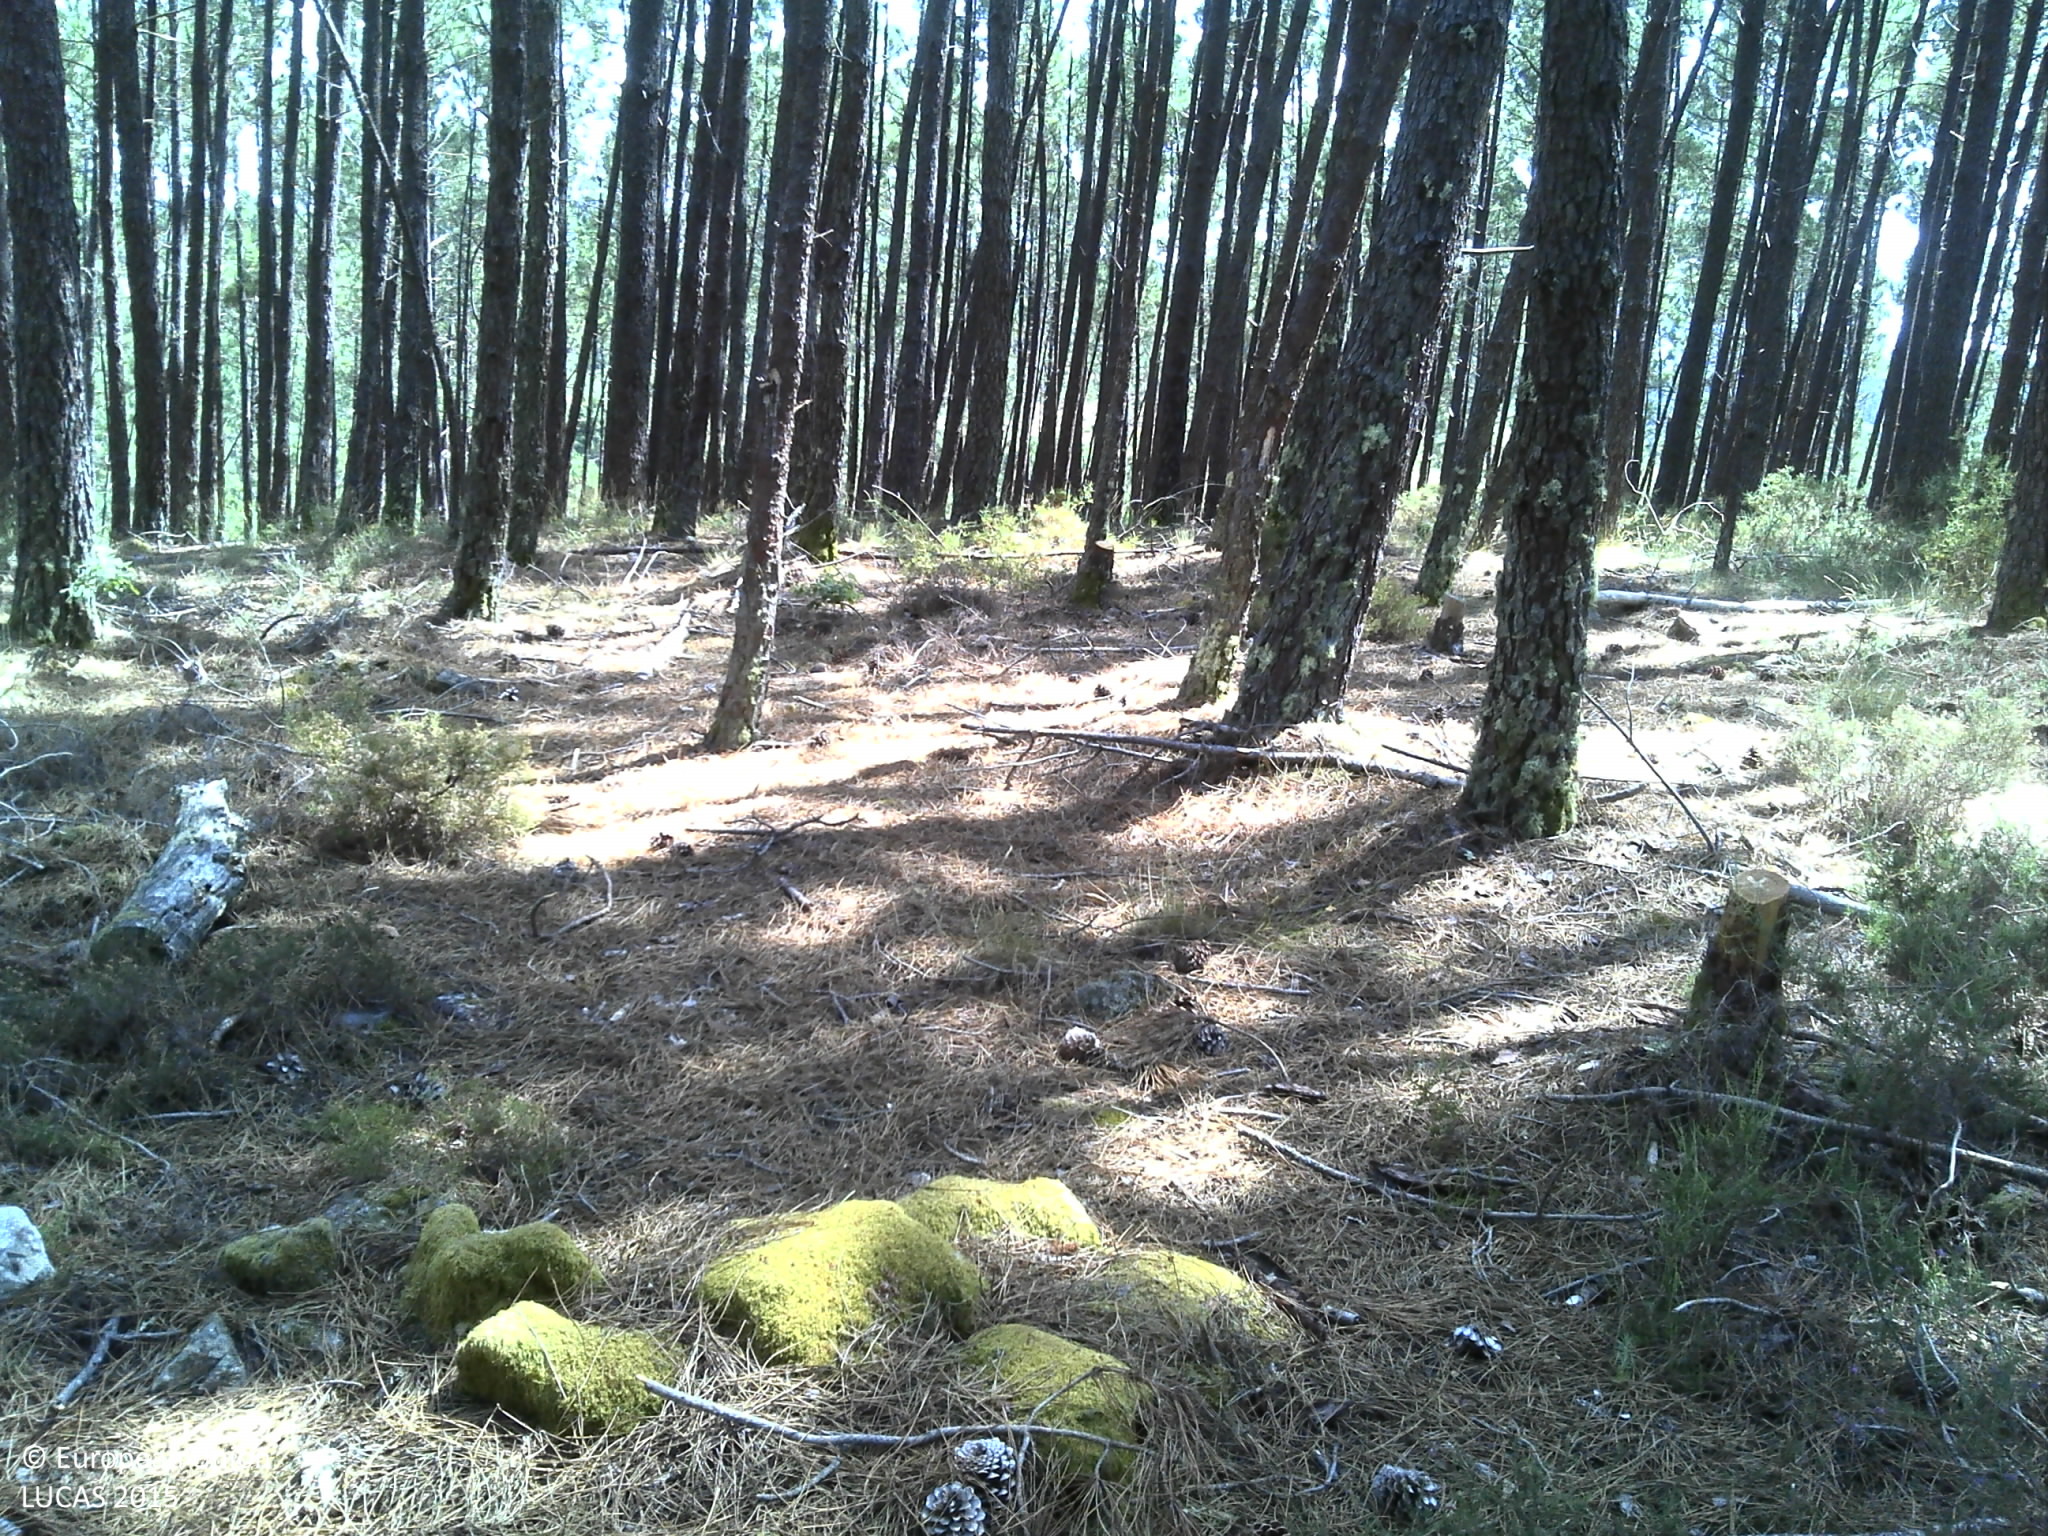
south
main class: Woodland
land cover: Pine dominated coniferous woodland
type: coniferous forest of the mediterranean region
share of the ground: > 75 %
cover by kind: coniferous forest trees 90 %, shrubs 5 %, unconsolidated bare surface 5 %
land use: Forestry
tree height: > 5 m
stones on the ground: 10 - 25 %
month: July
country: PT
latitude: 41.6363
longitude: -8.0926
